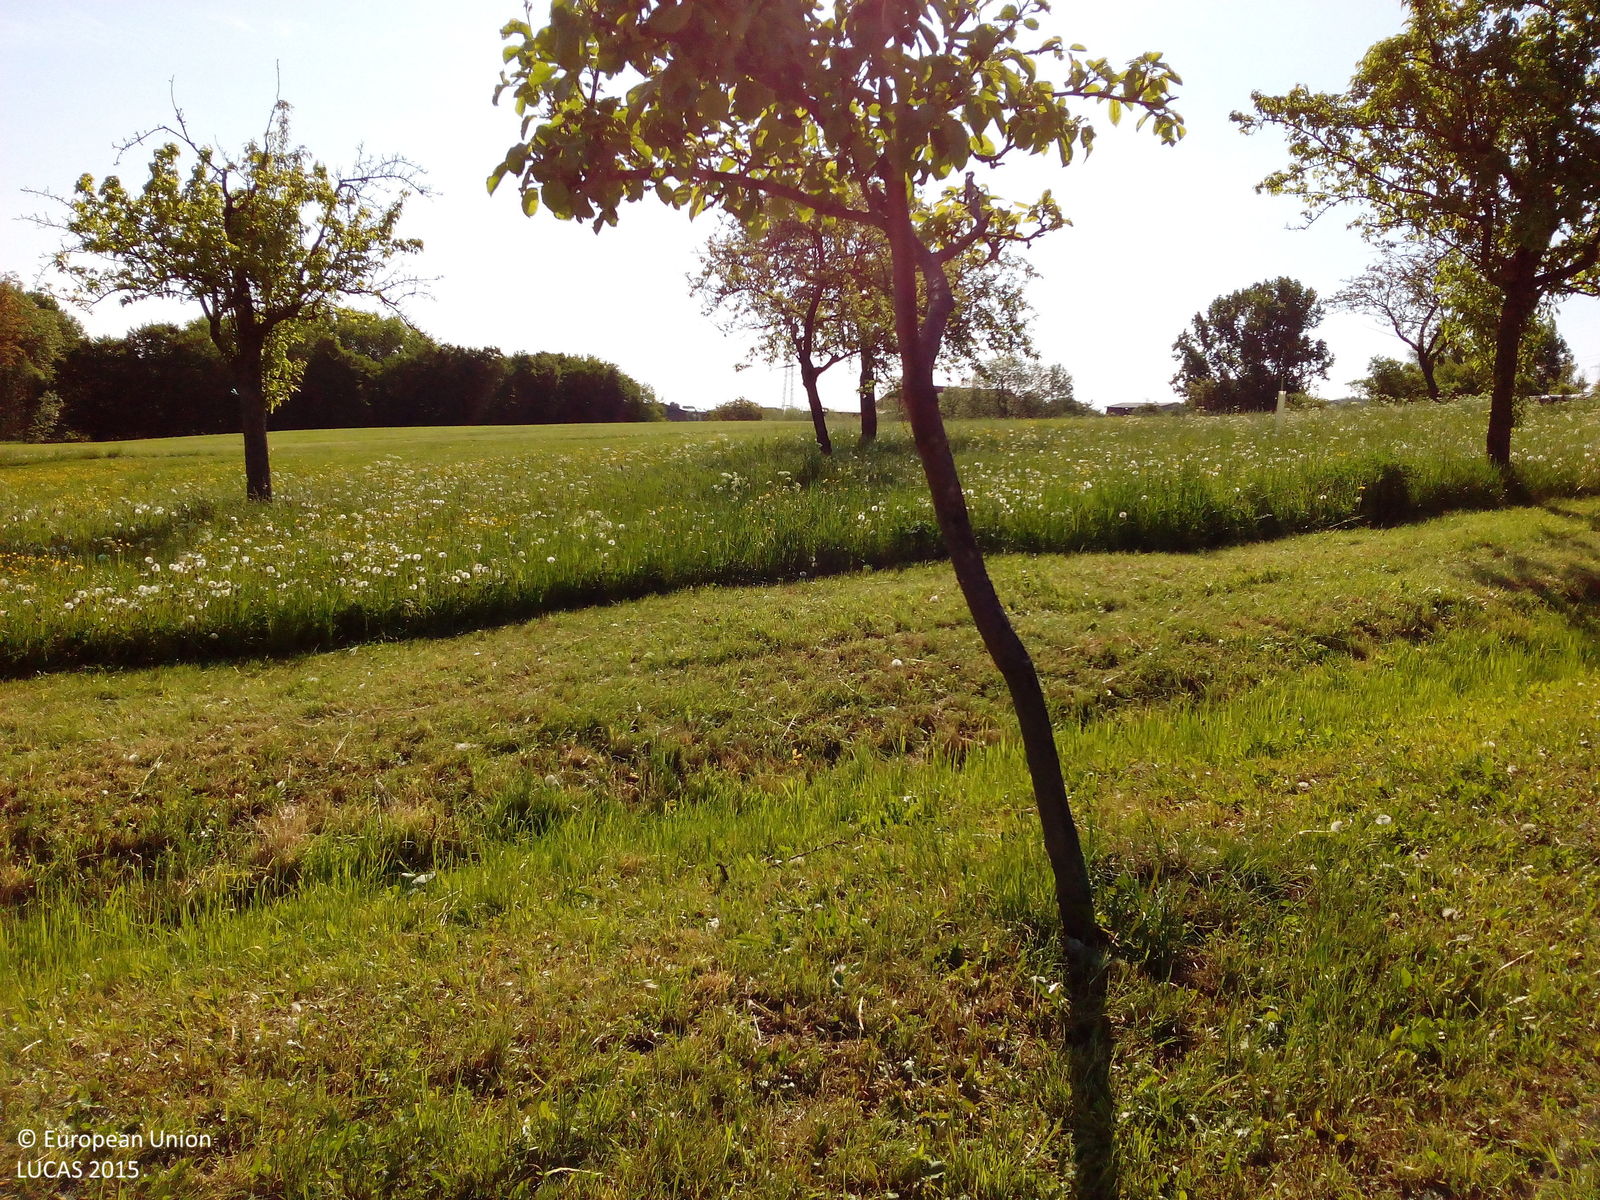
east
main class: Cropland
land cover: Apple fruit
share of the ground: 25 - 50 %
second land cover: Grassland without tree/shrub cover
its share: > 75 %
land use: Agriculture (excluding fallow land and kitchen gardens)
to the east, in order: Apple fruit; Grassland without tree/shrub cover; Tracks; Grassland without tree/shrub cover; Broadleaved woodland; Paved roads, cycling and walking lanes; Grass margins; Ditches and canals; Grass margins; Broadleaved woodland; Fences; Grassland without tree/shrub cover
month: May
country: DE
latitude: 50.8582
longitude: 11.4629
